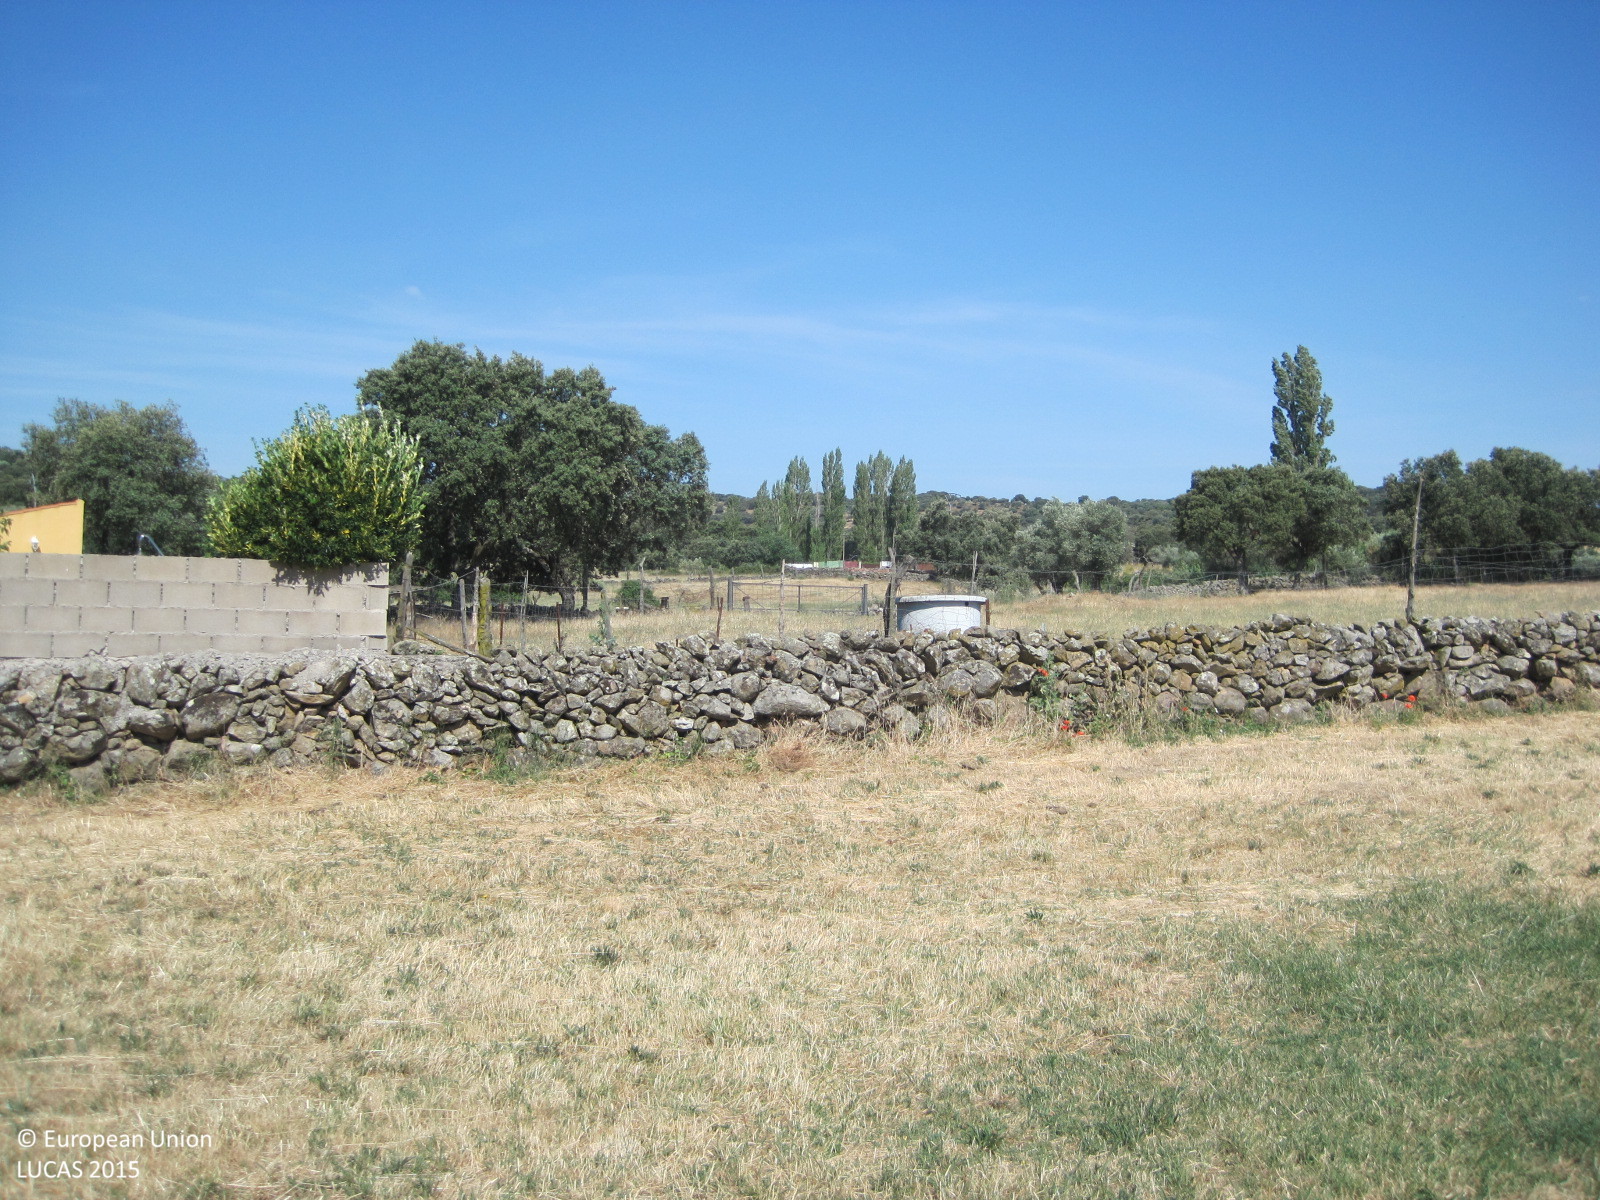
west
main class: Grassland
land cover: Grassland without tree/shrub cover
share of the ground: > 75 %
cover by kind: herbaceous plants 100 %
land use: Agriculture (excluding fallow land and kitchen gardens)
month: June
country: ES
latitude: 40.0547
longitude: -4.8076
